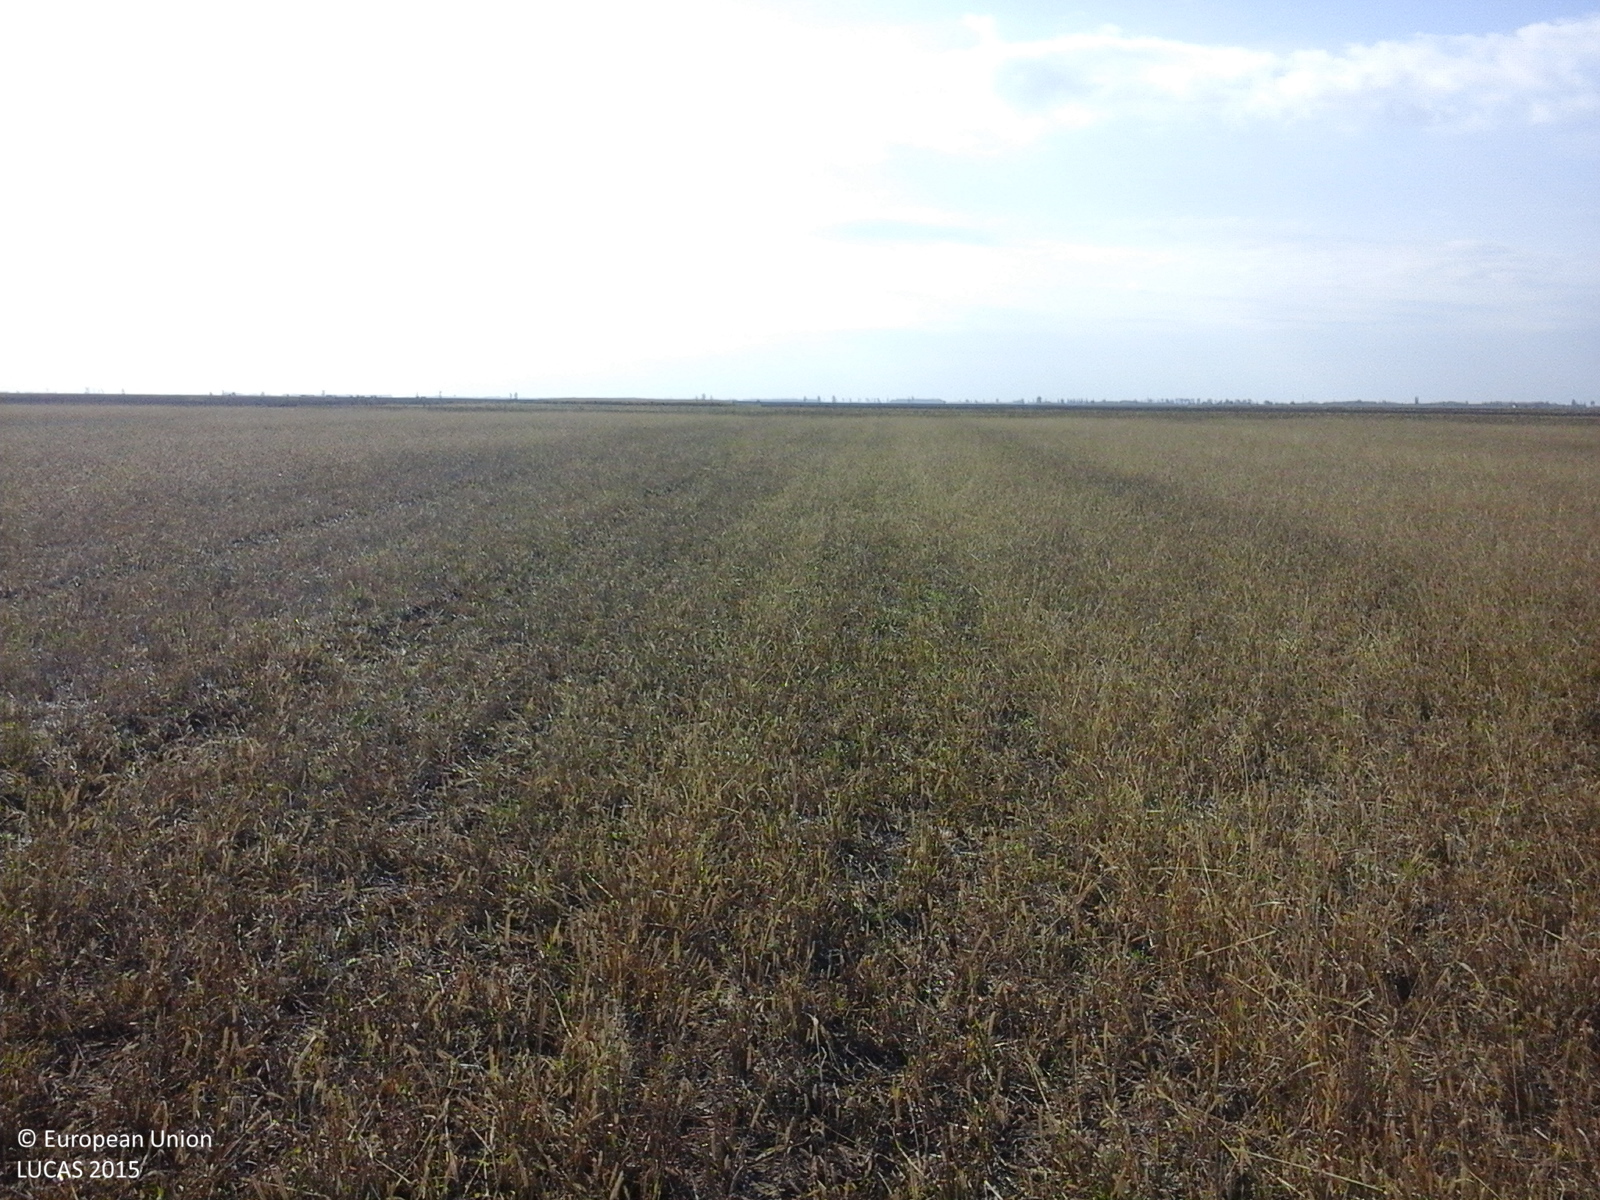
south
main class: Cropland
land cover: Barley
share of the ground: 25 - 50 %
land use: Agriculture (excluding fallow land and kitchen gardens)
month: October
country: RO
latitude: 45.2090
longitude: 27.2687
